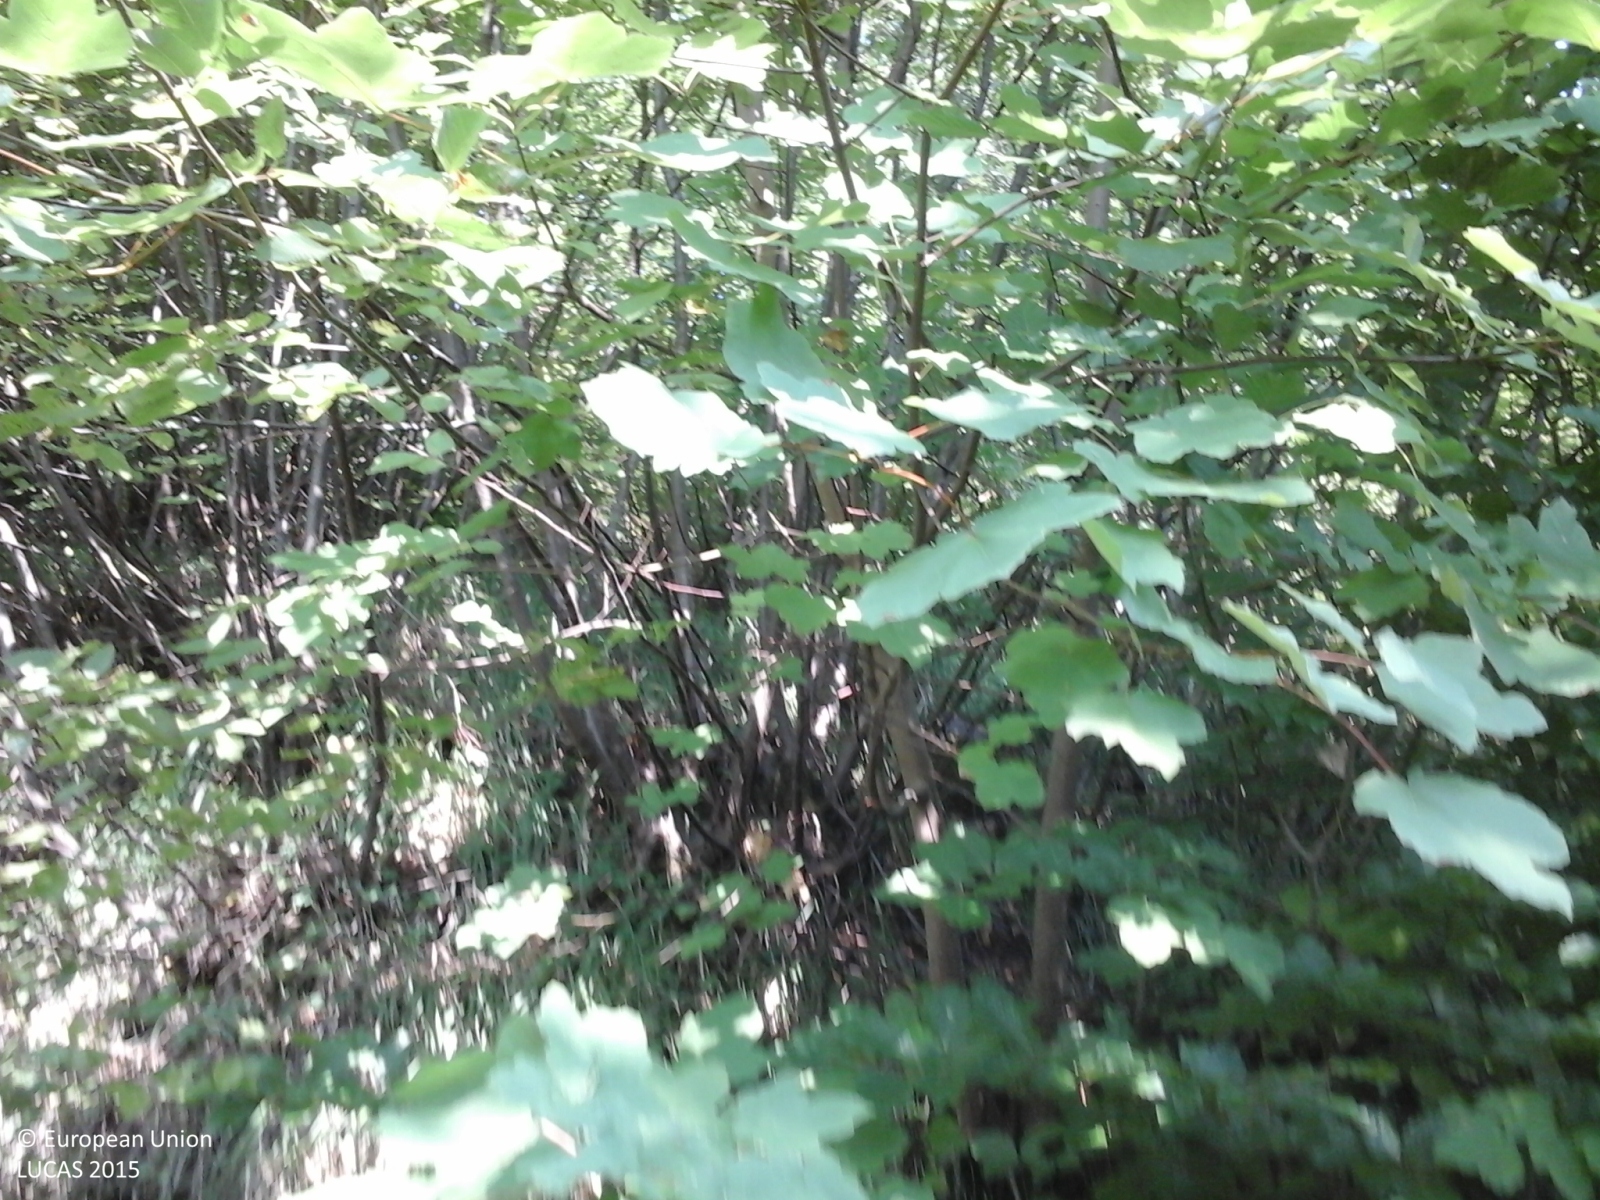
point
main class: Woodland
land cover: Broadleaved woodland
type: thermophilous deciduous forest
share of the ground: > 75 %
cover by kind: broadleaved forest trees 100 %
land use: Forestry
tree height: > 5 m
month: August
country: IT
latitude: 43.7494
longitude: 12.2174
